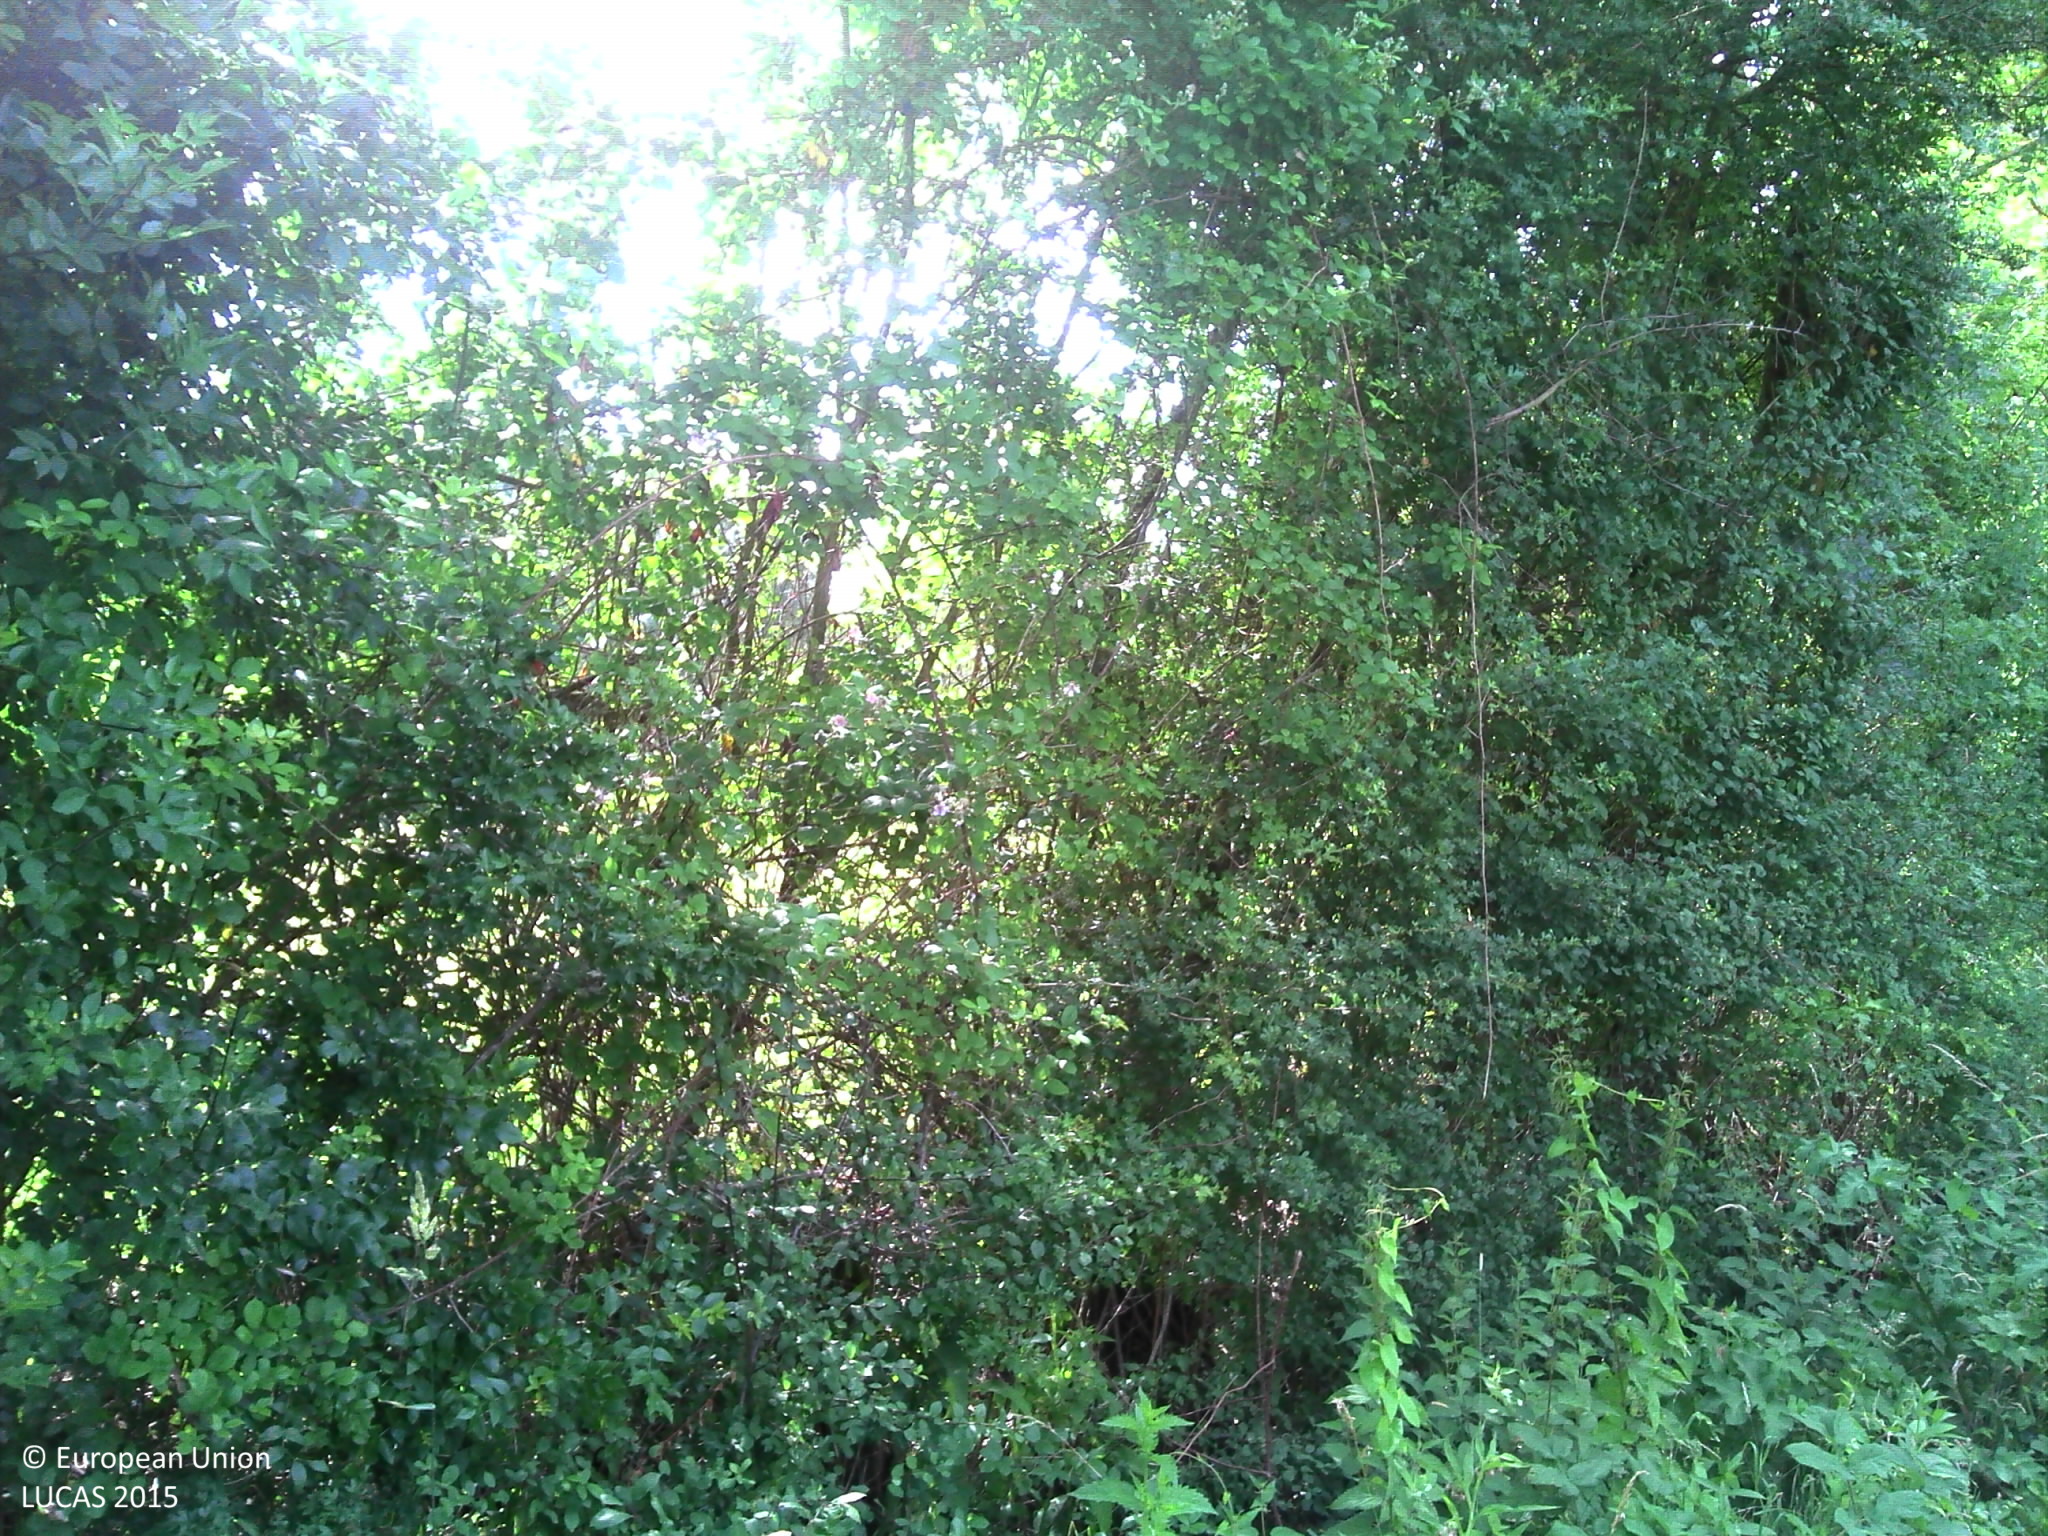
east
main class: Grassland
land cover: Grassland without tree/shrub cover
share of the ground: > 75 %
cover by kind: herbaceous plants 100 %
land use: Agriculture (excluding fallow land and kitchen gardens)
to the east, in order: Grassland without tree/shrub cover; Ditches and canals; Managed hedges; Fences; Lines of trees; Grassland without tree/shrub cover; Managed hedges; Fences; Lines of trees; Common wheat; Lines of trees; Maize
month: June
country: FR
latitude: 47.2646
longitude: 0.0499
